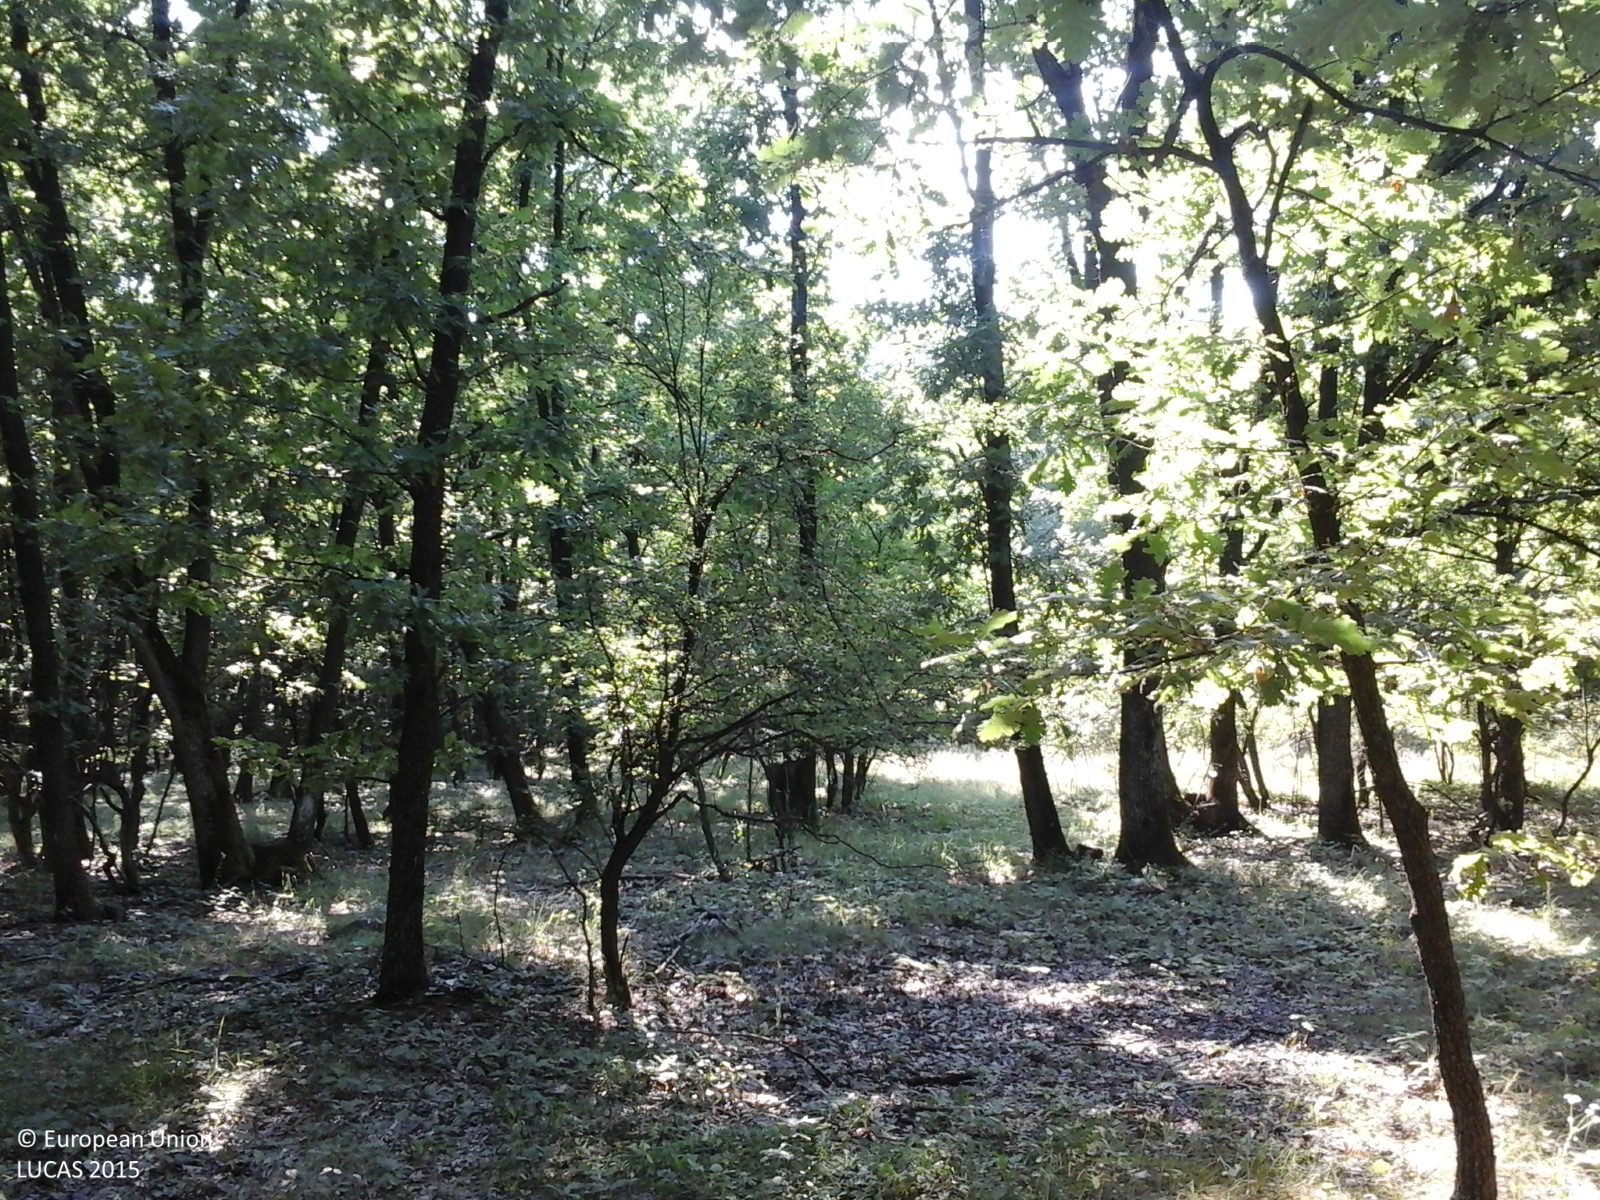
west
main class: Woodland
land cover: Broadleaved woodland
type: acidophilous oak and oak-birch forest
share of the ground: > 75 %
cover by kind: broadleaved forest trees 100 %
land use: Forestry
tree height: > 5 m
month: July
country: RO
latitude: 44.7022
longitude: 24.6012
